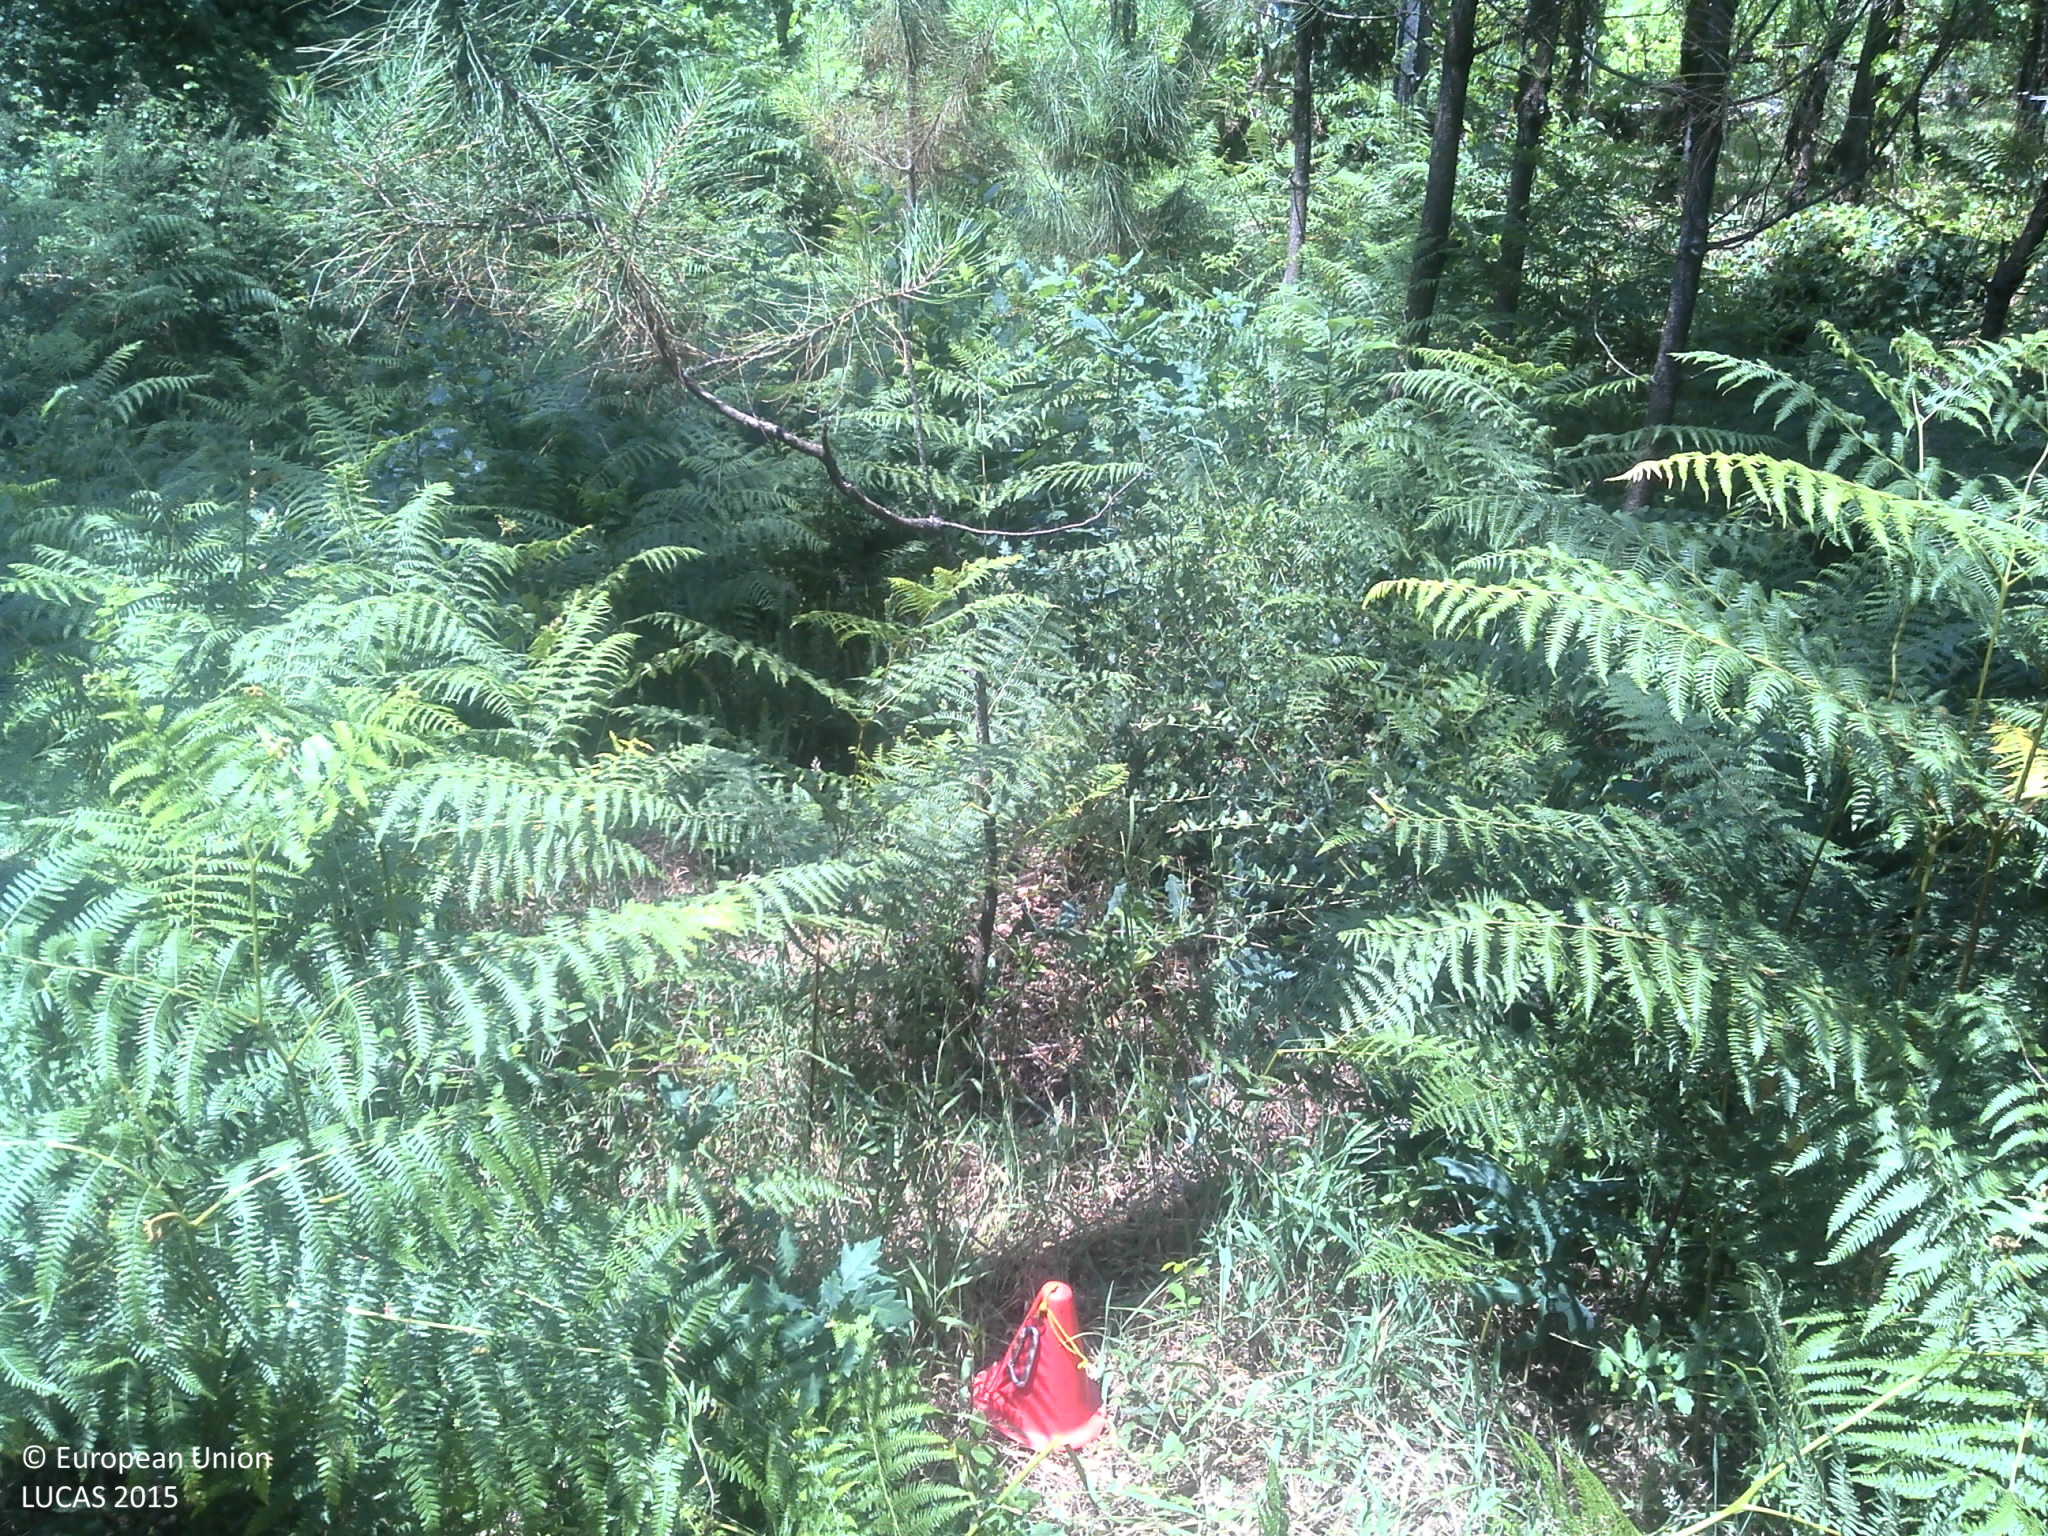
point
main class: Woodland
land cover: Pine dominated coniferous woodland
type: coniferous forest of the mediterranean region
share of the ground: 50 - 75 %
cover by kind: coniferous forest trees 70 %, shrubs 20 %, herbaceous plants 5 %, unconsolidated bare surface 5 %
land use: Forestry
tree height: > 5 m
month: June
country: PT
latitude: 41.5971
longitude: -8.5999
